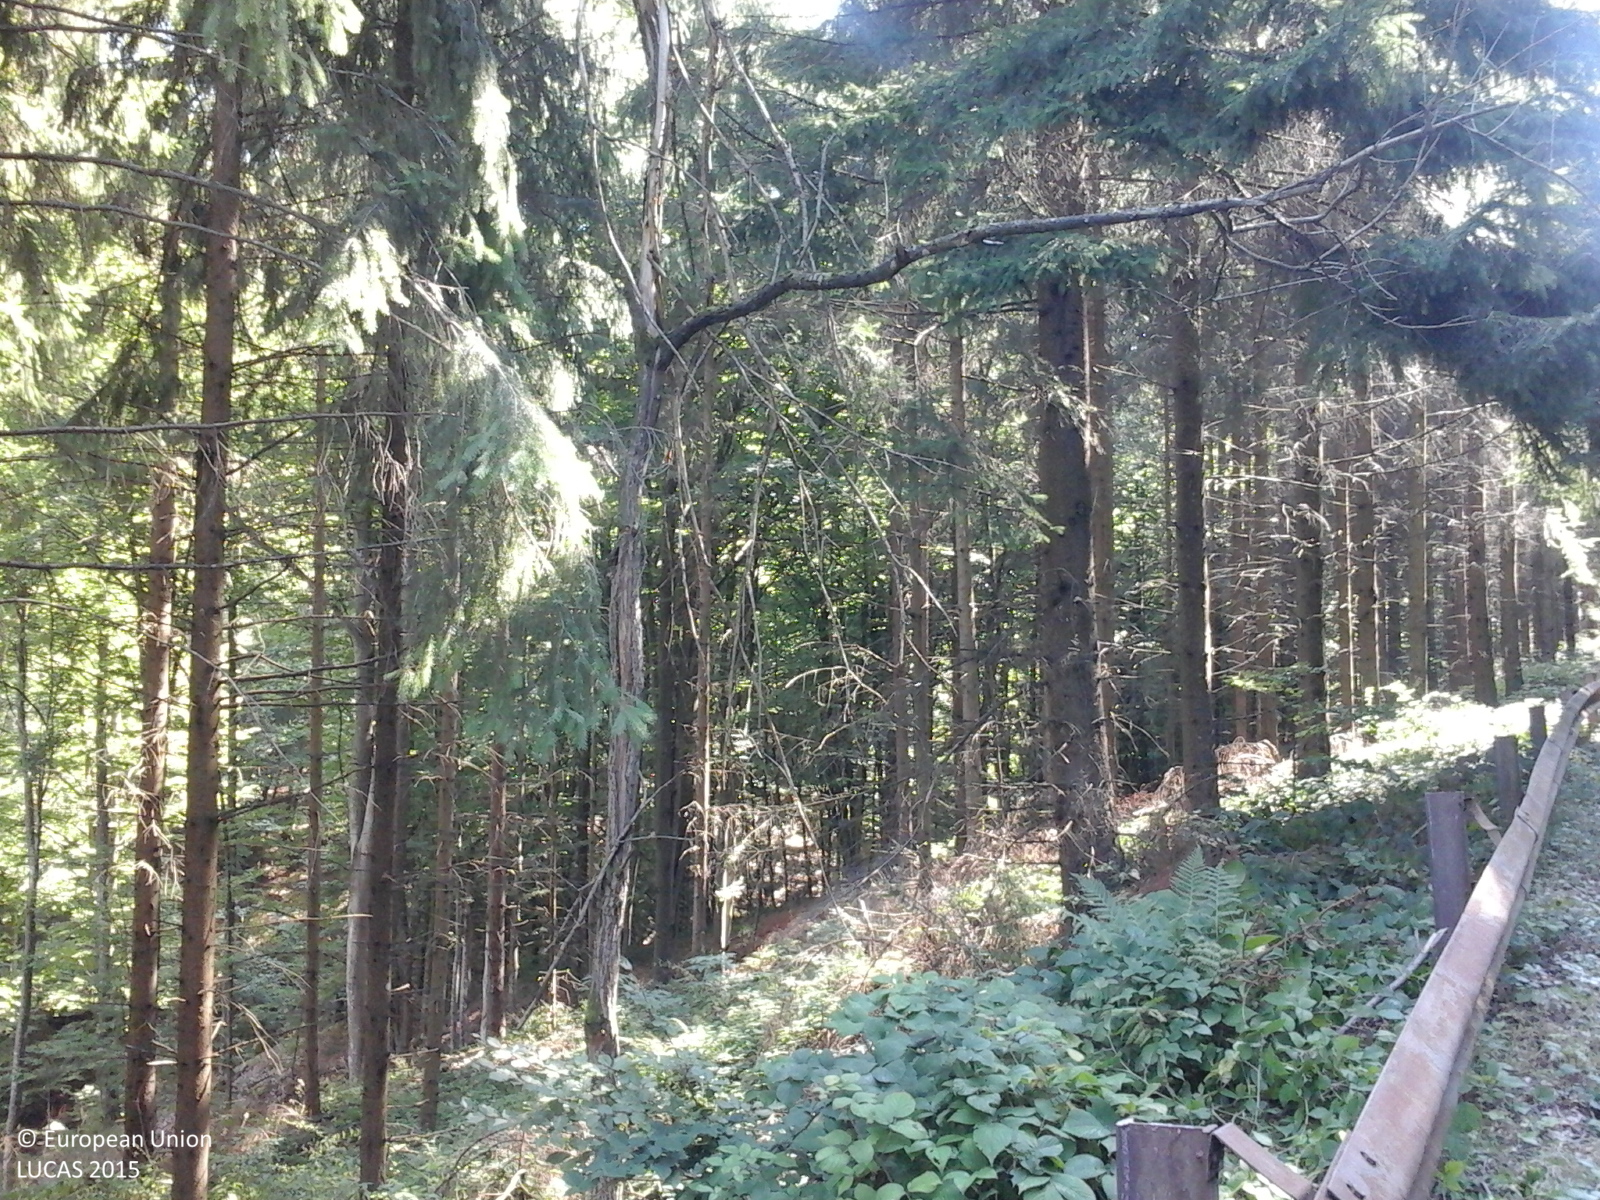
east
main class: Woodland
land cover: Spruce dominated mixed woodland
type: hemiboreal forest and nemoral coniferous forest and mixed broadleaved-coniferous forest
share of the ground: > 75 %
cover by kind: coniferous forest trees 60 %, broadleaved forest trees 40 %
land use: Forestry
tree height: > 5 m
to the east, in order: Grass margins; Artificial constructions; Spruce dominated mixed woodland
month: September
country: RO
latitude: 46.6847
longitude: 22.5393
